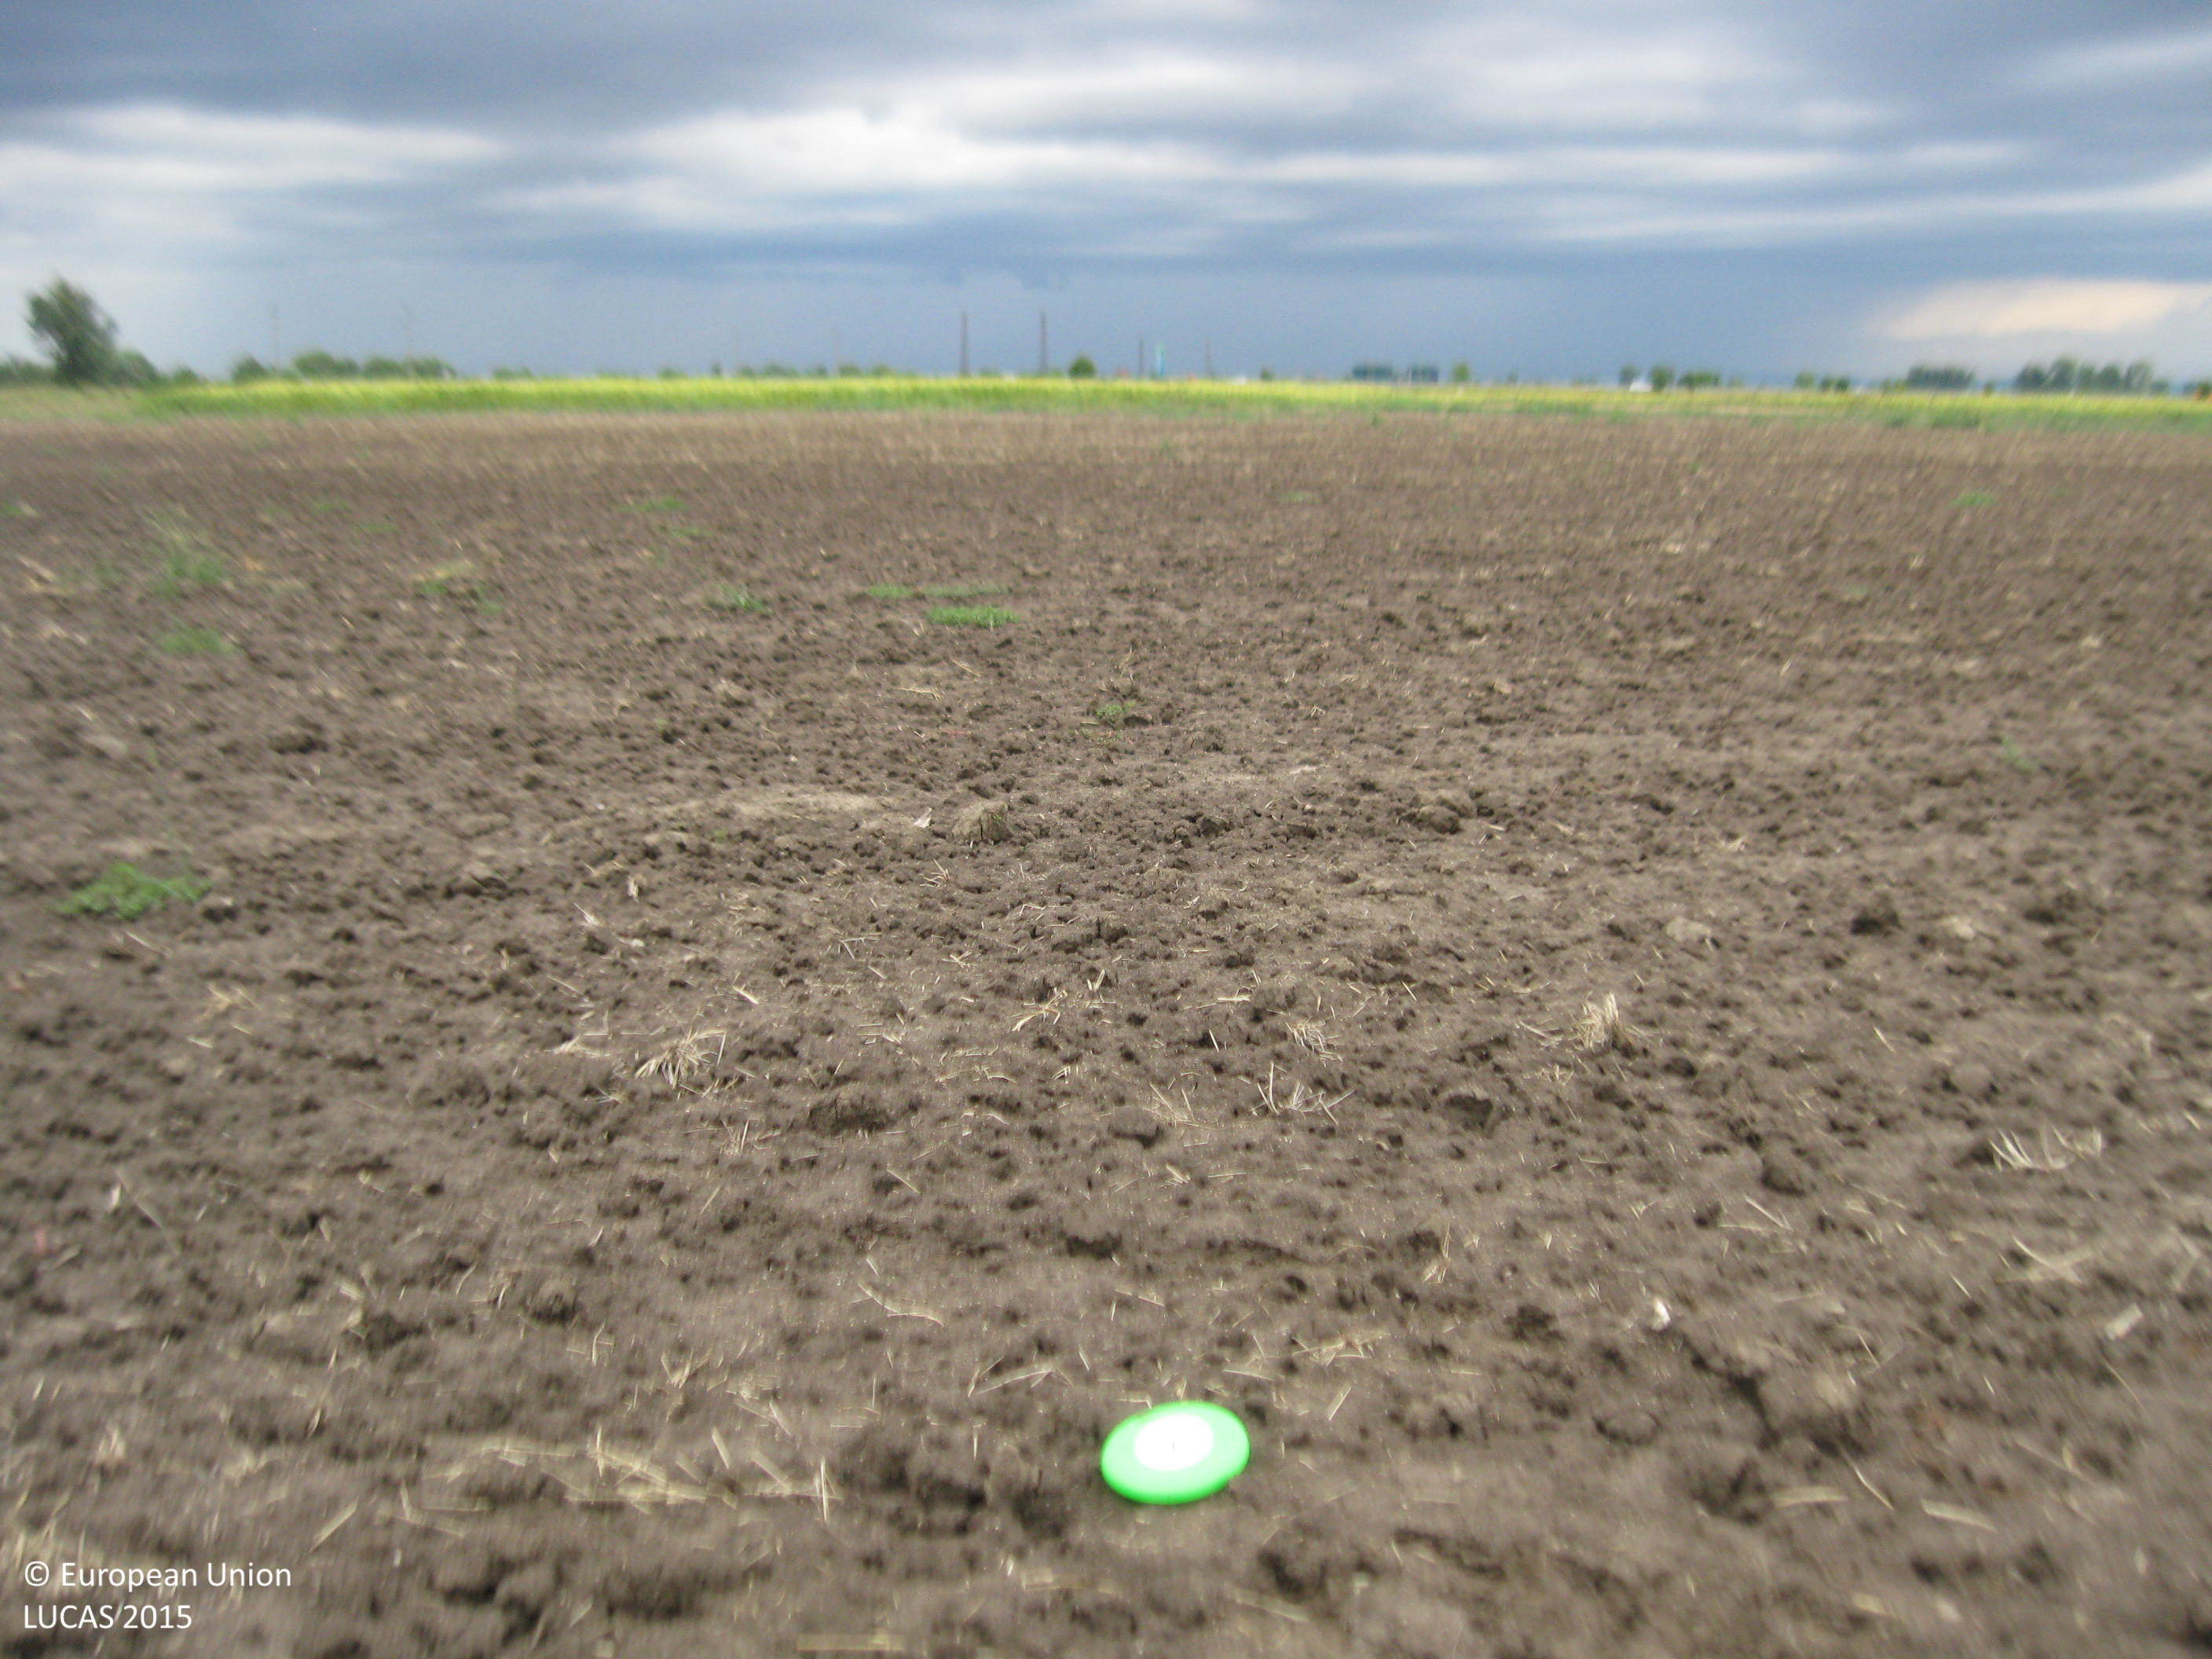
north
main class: Cropland
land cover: Common wheat
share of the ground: < 10 %
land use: Agriculture (excluding fallow land and kitchen gardens)
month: August
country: BG
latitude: 42.2096
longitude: 24.7447
